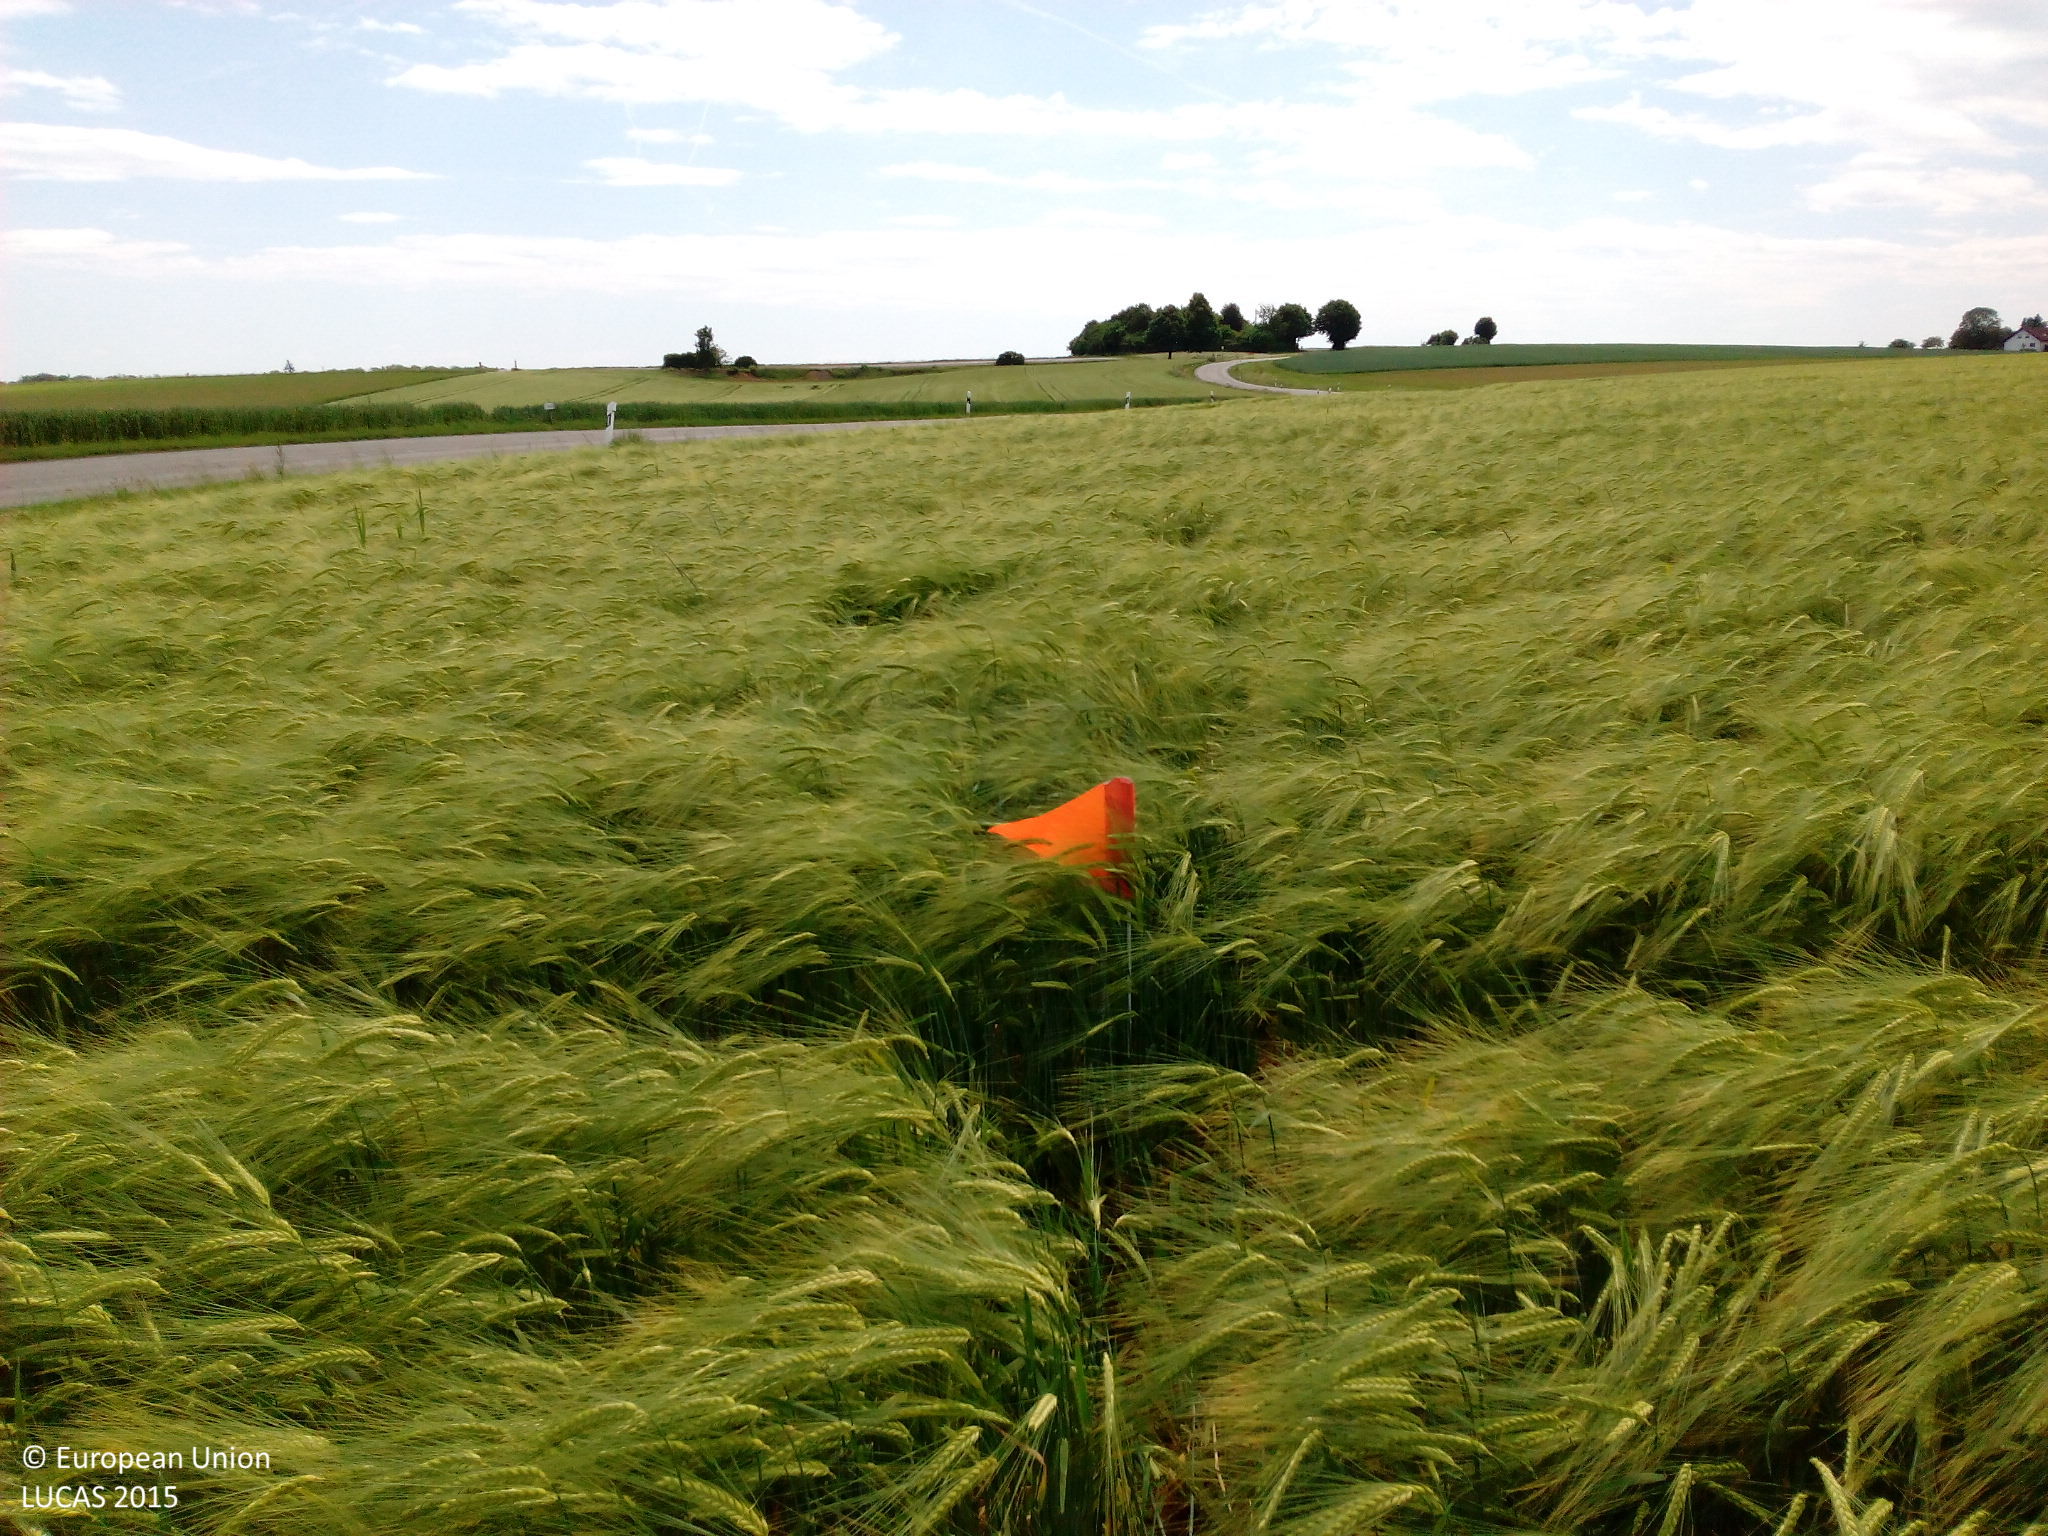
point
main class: Cropland
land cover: Rye
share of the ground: > 75 %
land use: Agriculture (excluding fallow land and kitchen gardens)
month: June
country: DE
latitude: 48.9594
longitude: 9.3584
